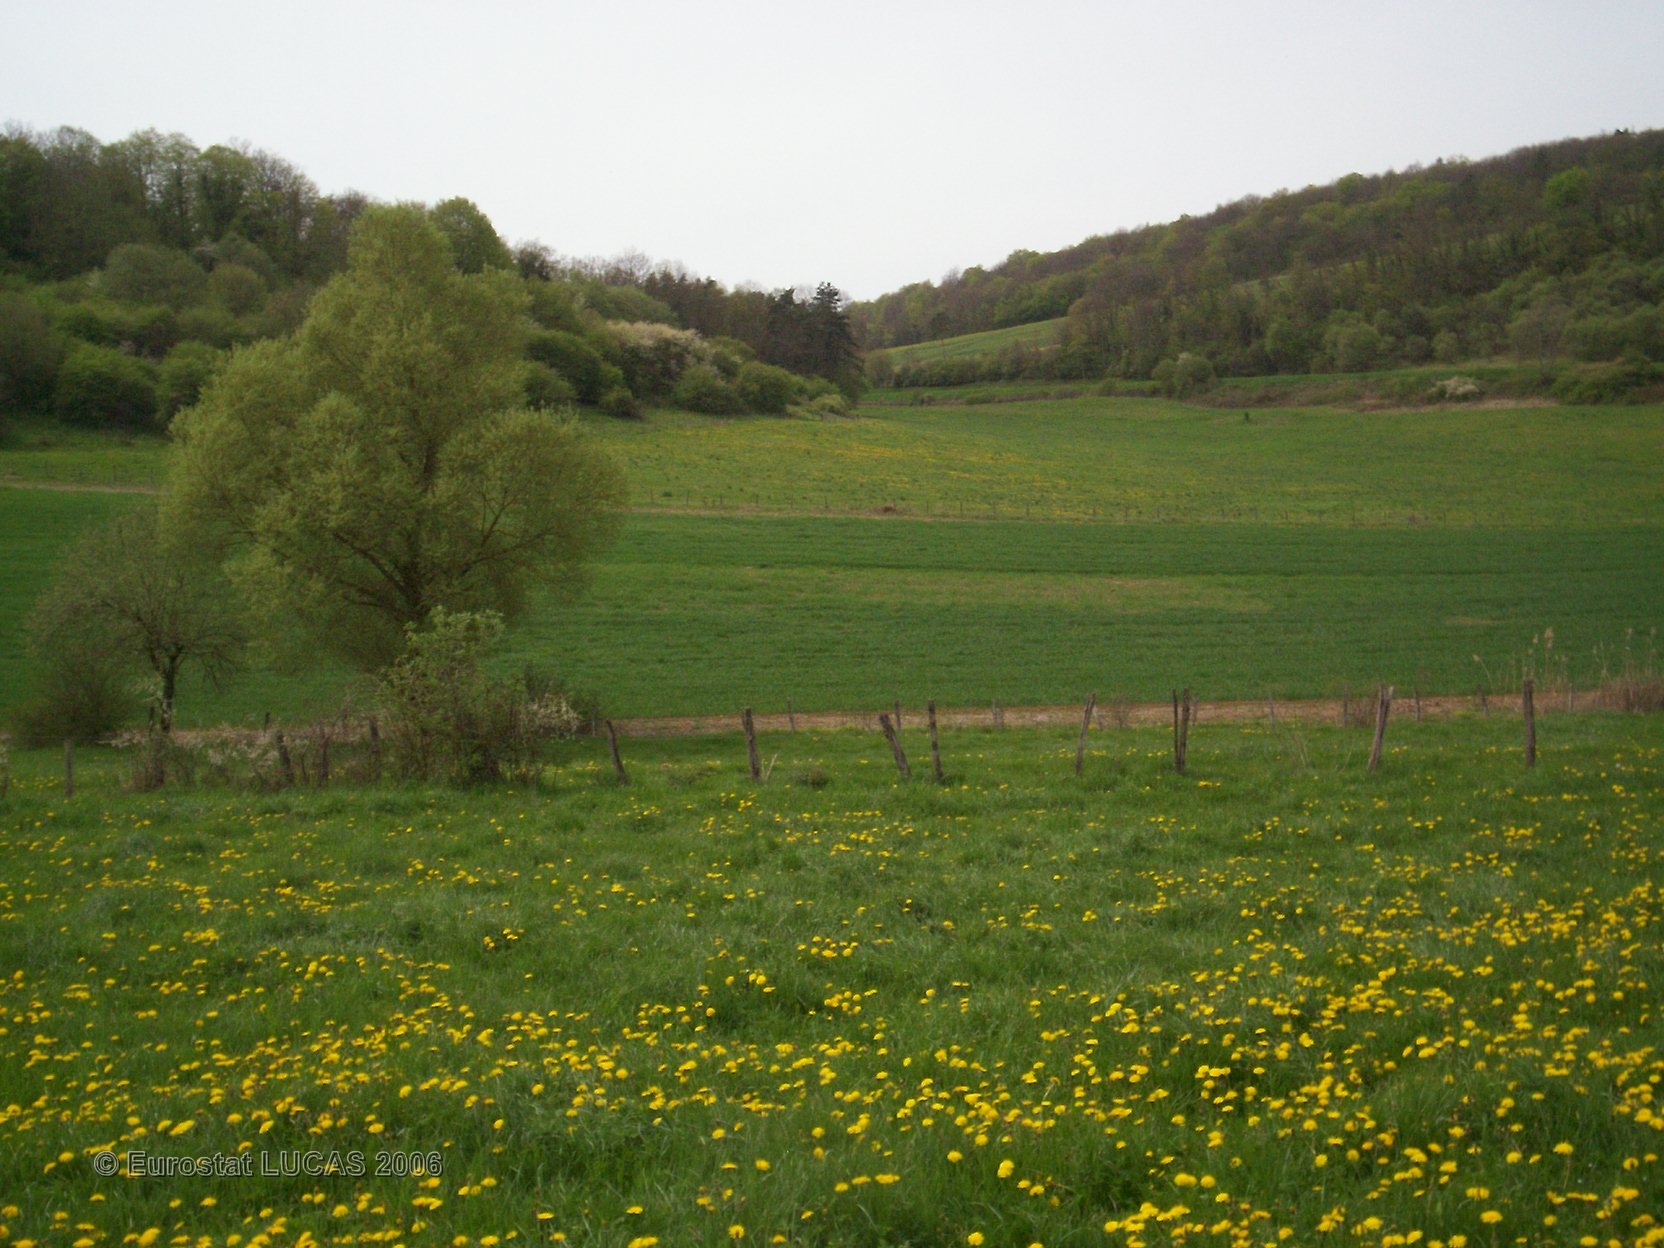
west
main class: Grassland
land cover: Grassland without tree/shrub cover
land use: Agriculture (excluding fallow land and kitchen gardens)
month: May
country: FR
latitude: 47.6946
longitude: 4.6025
